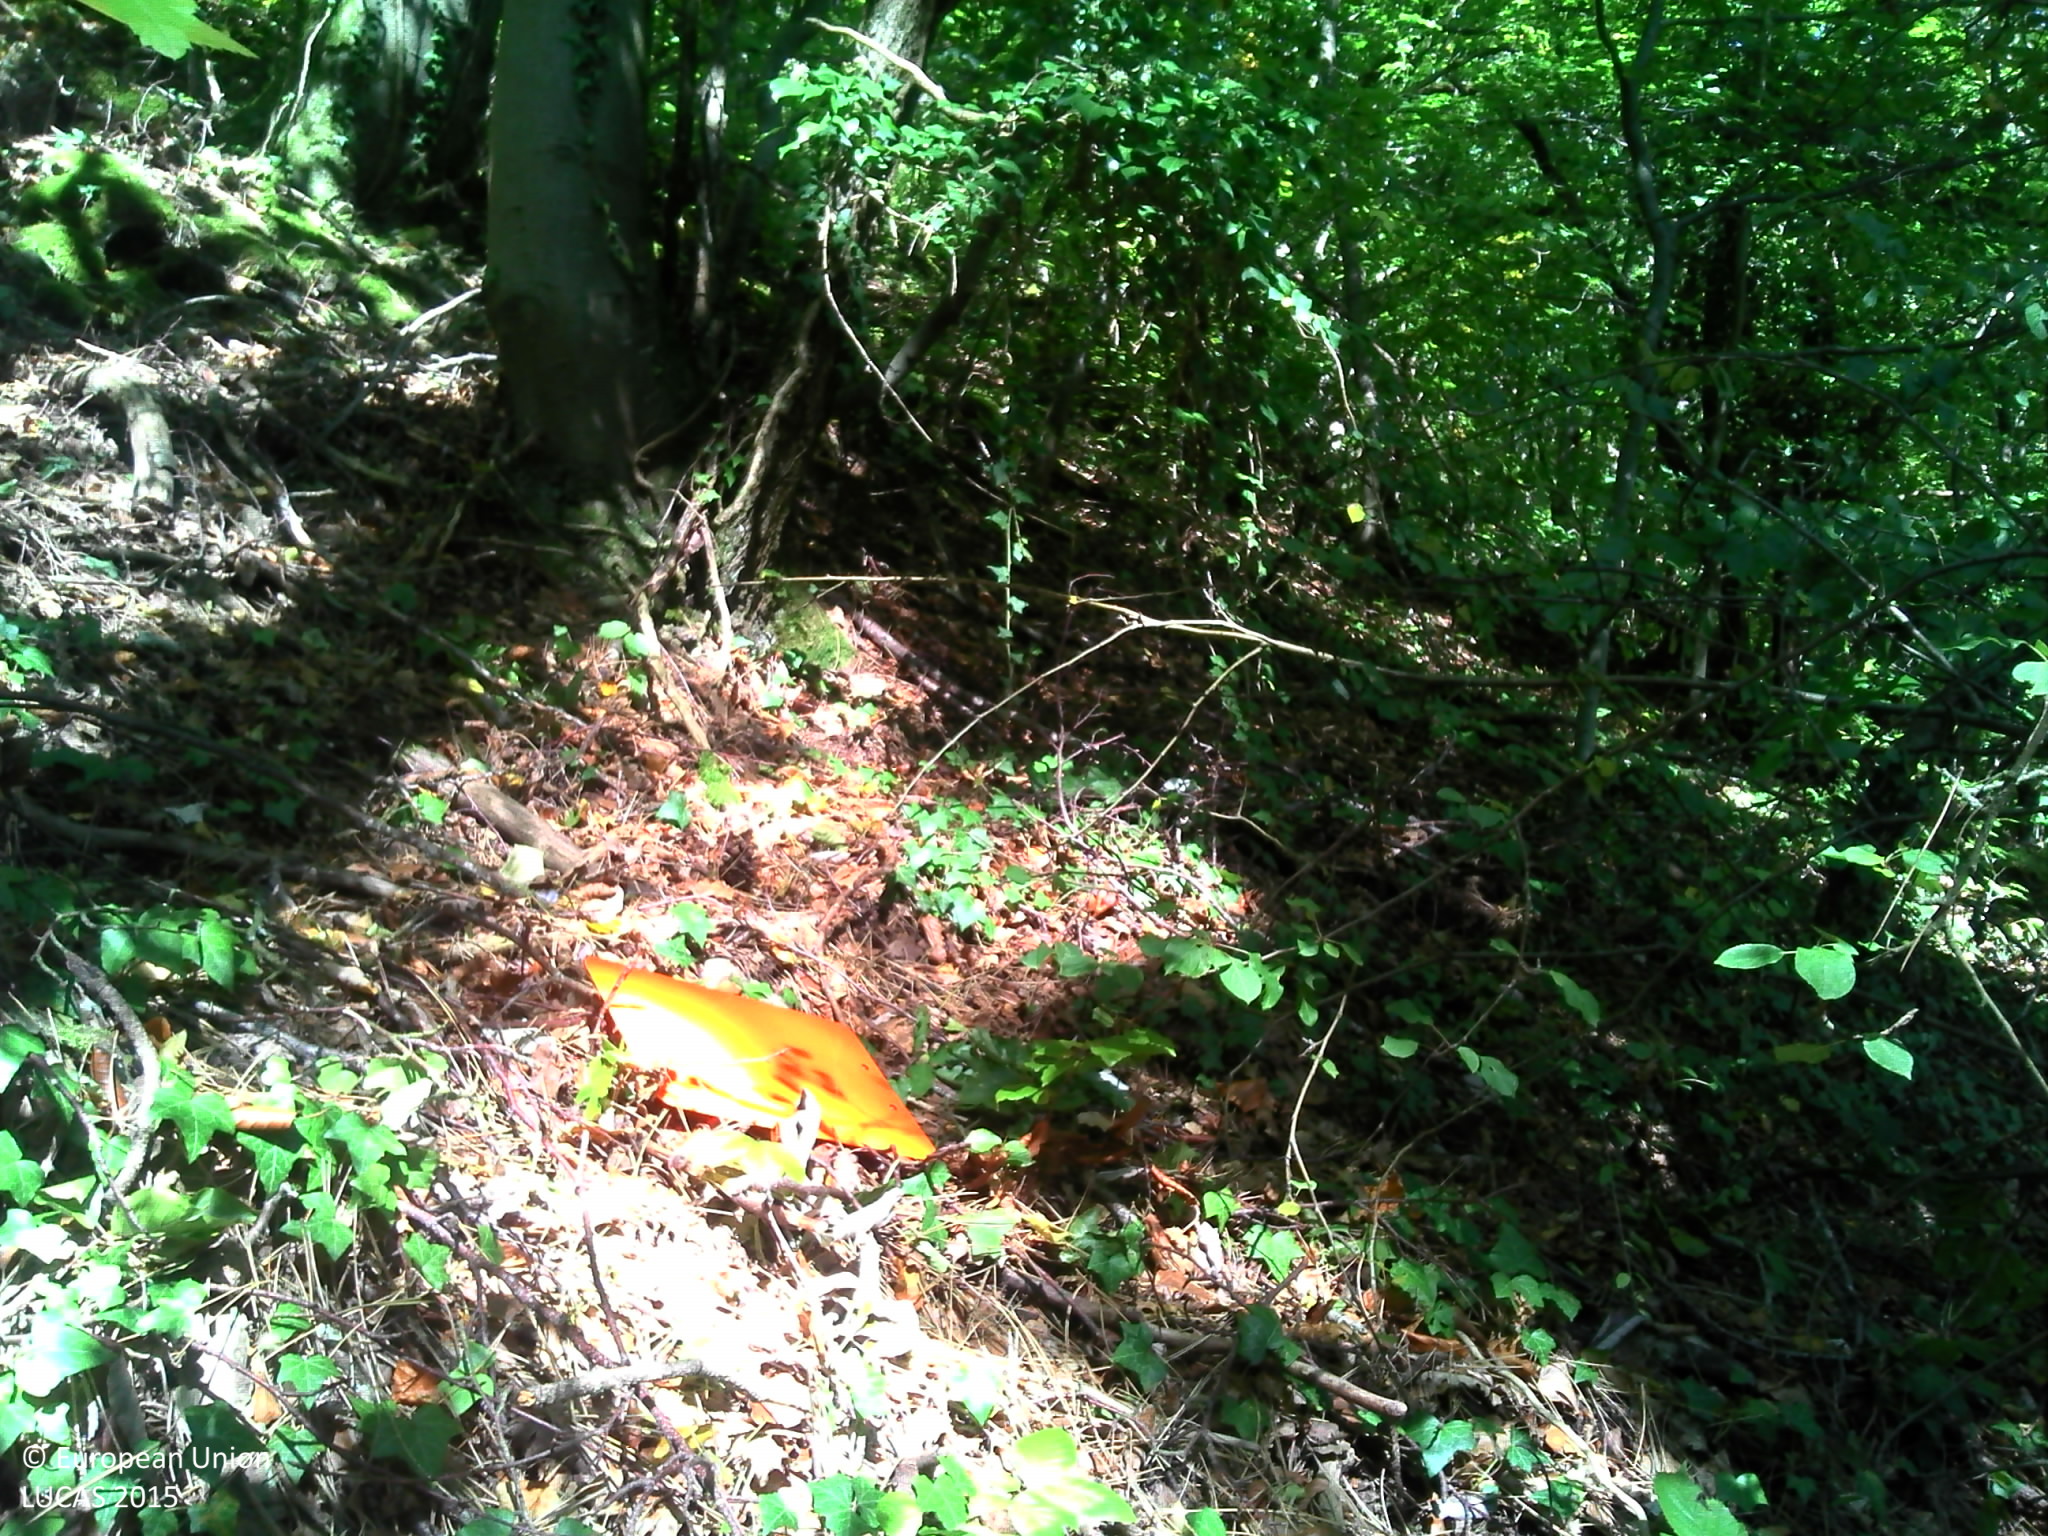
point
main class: Woodland
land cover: Pine dominated mixed woodland
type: hemiboreal forest and nemoral coniferous forest and mixed broadleaved-coniferous forest
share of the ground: > 75 %
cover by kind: coniferous forest trees 45 %, broadleaved forest trees 40 %, herbaceous plants 10 %, consolidated bare surface 5 %
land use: Forestry
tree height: > 5 m
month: October
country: FR
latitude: 48.9945
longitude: 5.9129
